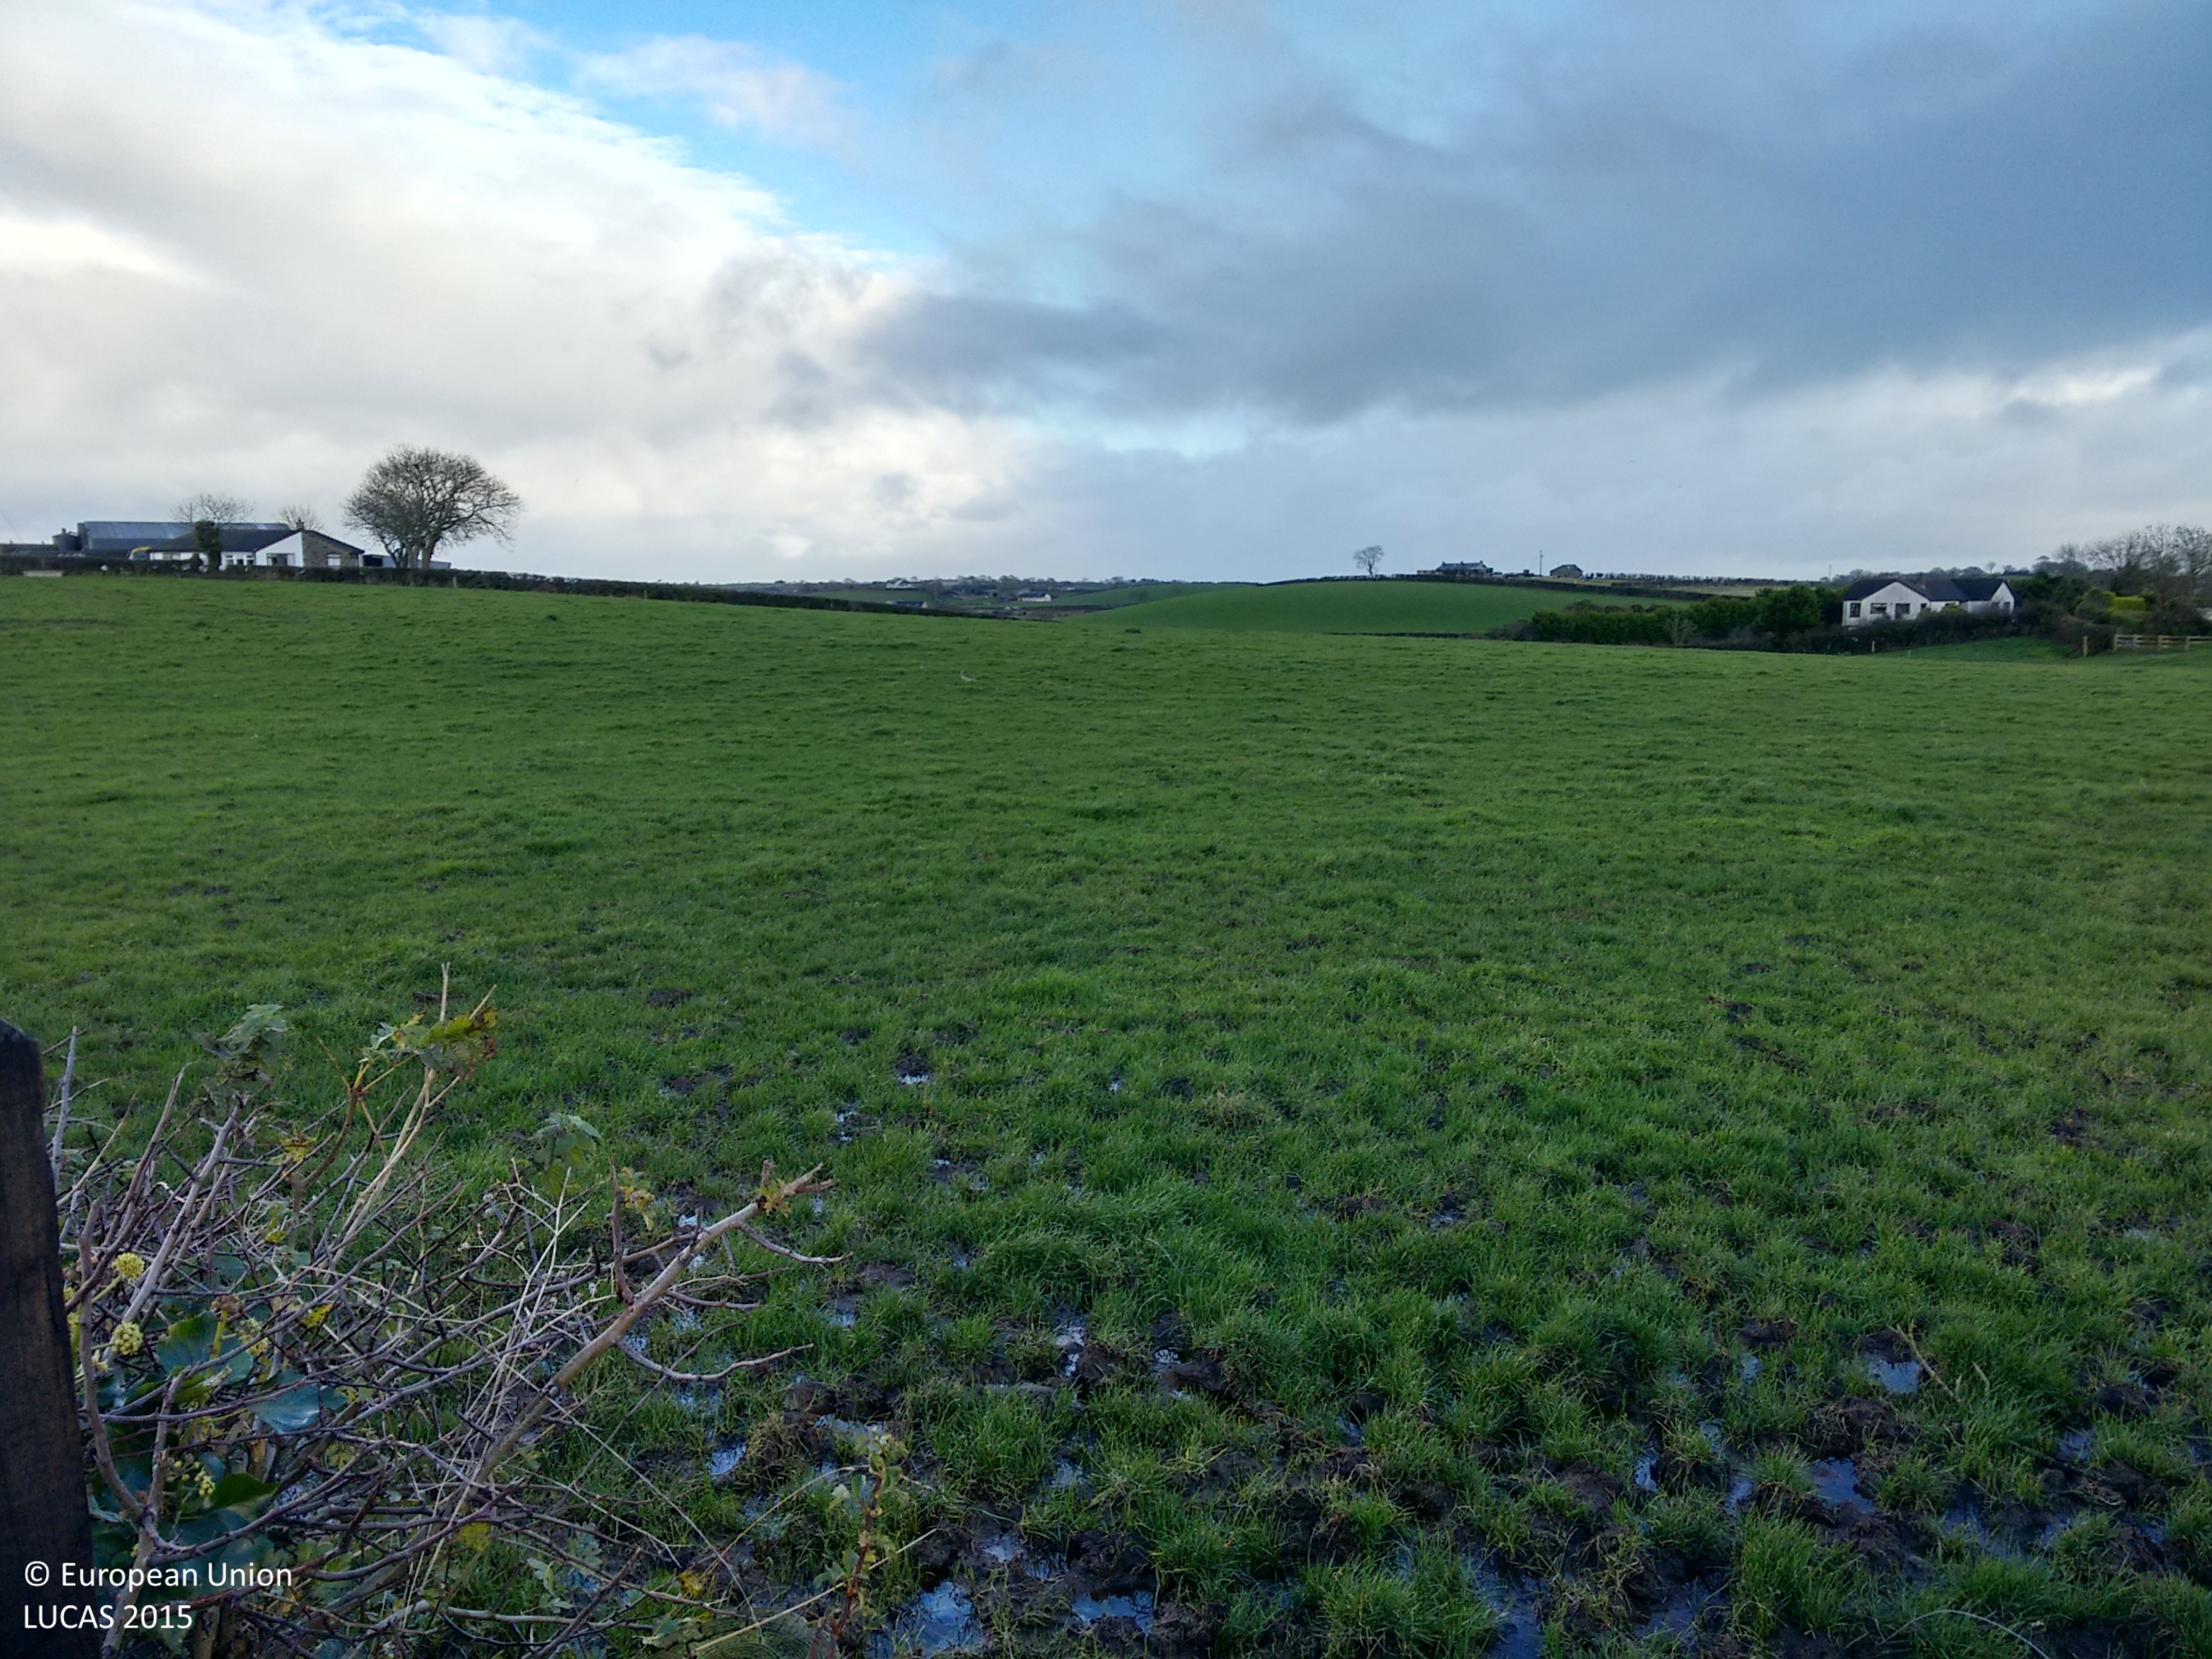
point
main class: Grassland
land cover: Grassland without tree/shrub cover
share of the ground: > 75 %
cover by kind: herbaceous plants 100 %
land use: Agriculture (excluding fallow land and kitchen gardens)
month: November
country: GB
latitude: 54.5842
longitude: -5.5873
